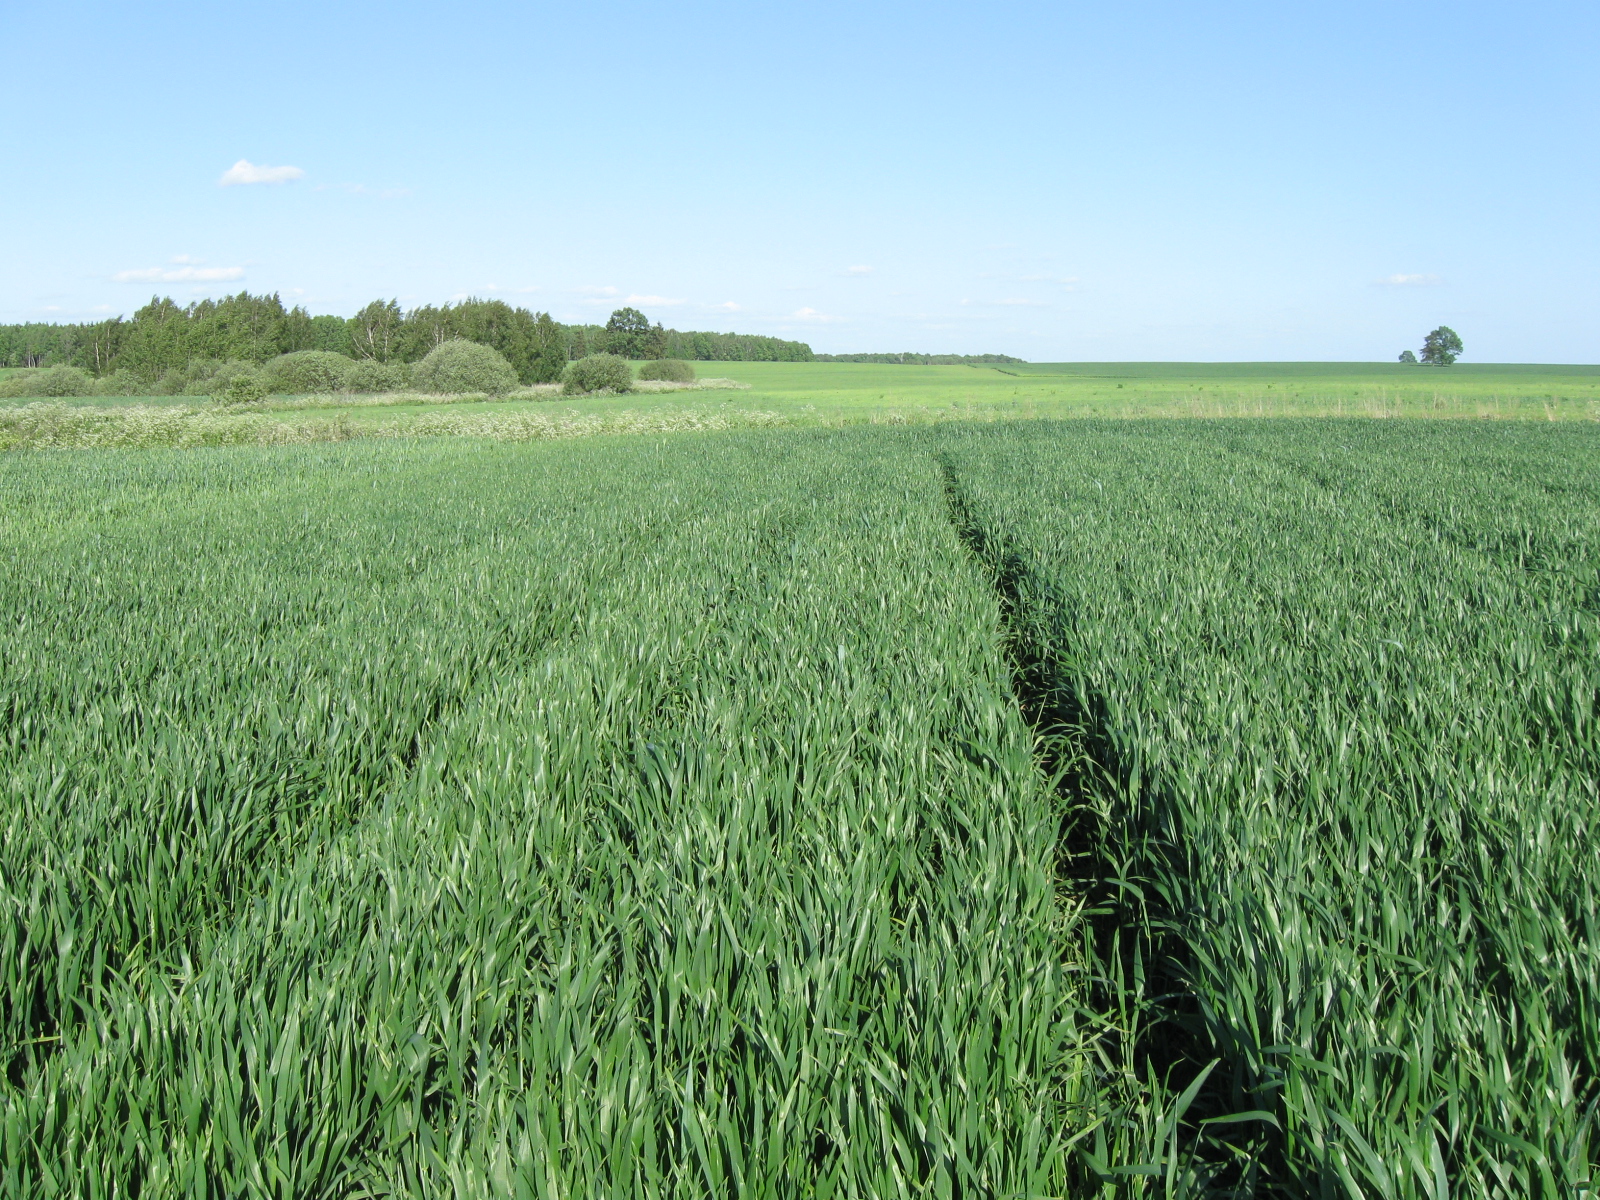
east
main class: Cropland
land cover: Common wheat
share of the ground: > 75 %
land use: Agriculture (excluding fallow land and kitchen gardens)
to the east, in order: Common wheat; Spontaneously vegetated surfaces; Ditches and canals; Spontaneously vegetated surfaces; Common wheat; Spontaneously vegetated surfaces; Ditches and canals; Spontaneously vegetated surfaces
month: June
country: LT
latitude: 54.4577
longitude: 23.7383
